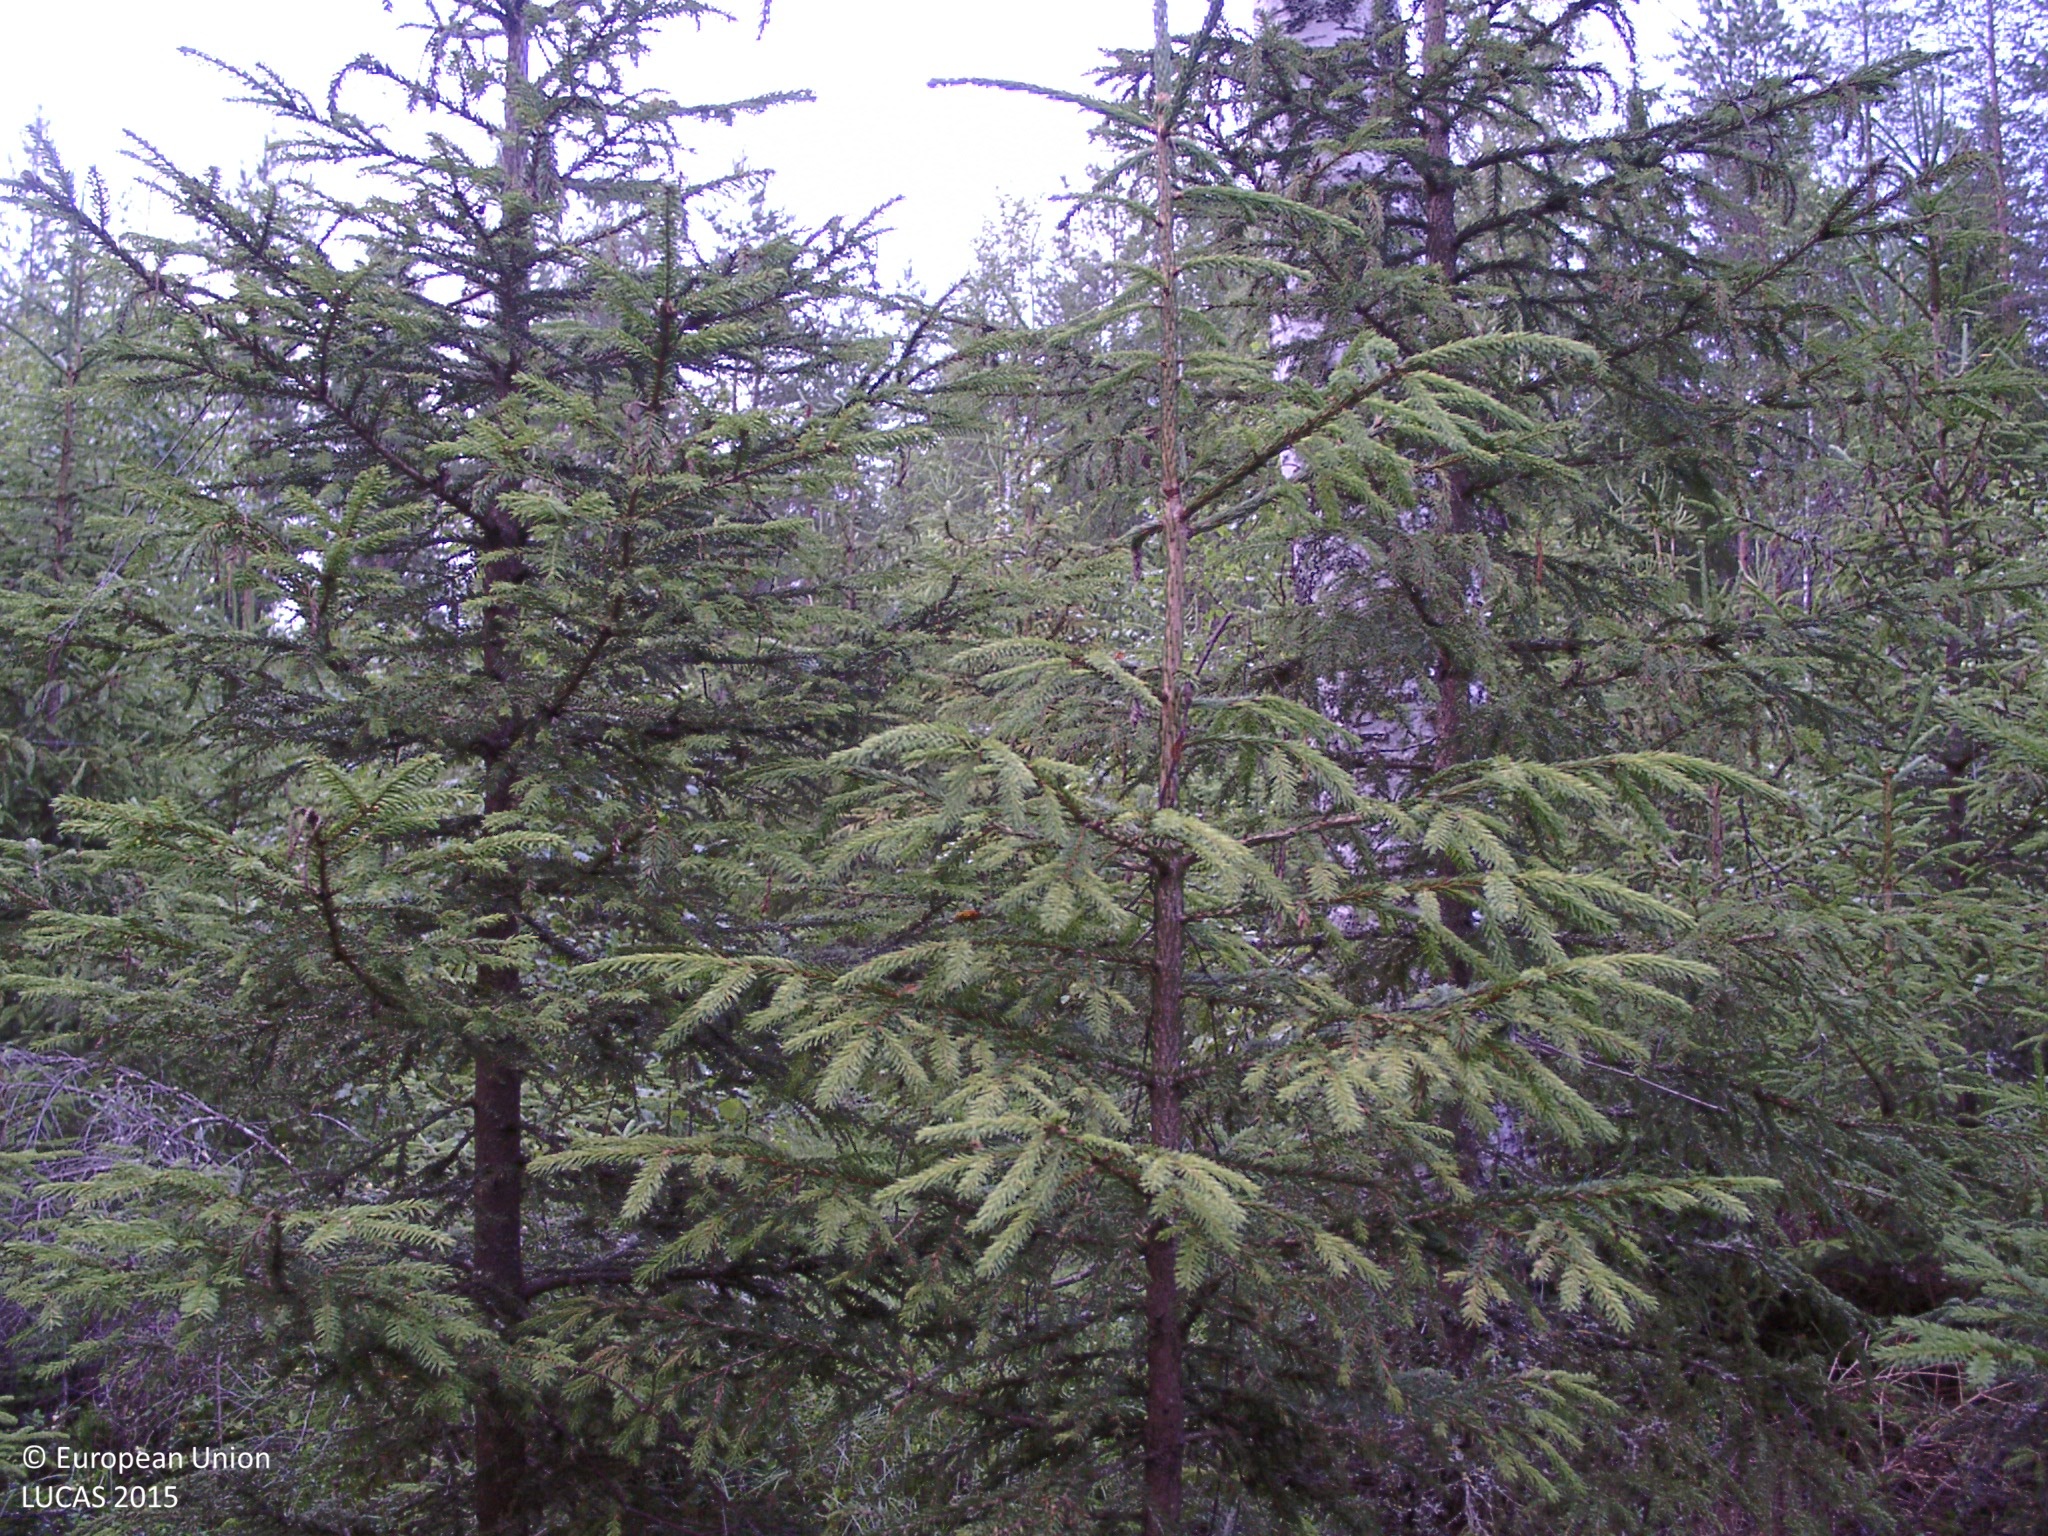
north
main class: Woodland
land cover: Spruce dominated mixed woodland
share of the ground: 50 - 75 %
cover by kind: coniferous forest trees 40 %, broadleaved forest trees 20 %, shrubs 20 %, herbaceous plants 5 %, lichens and mosses 5 %, unconsolidated bare surface 5 %
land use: Forestry
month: July
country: FI
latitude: 62.3255
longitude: 25.2582
